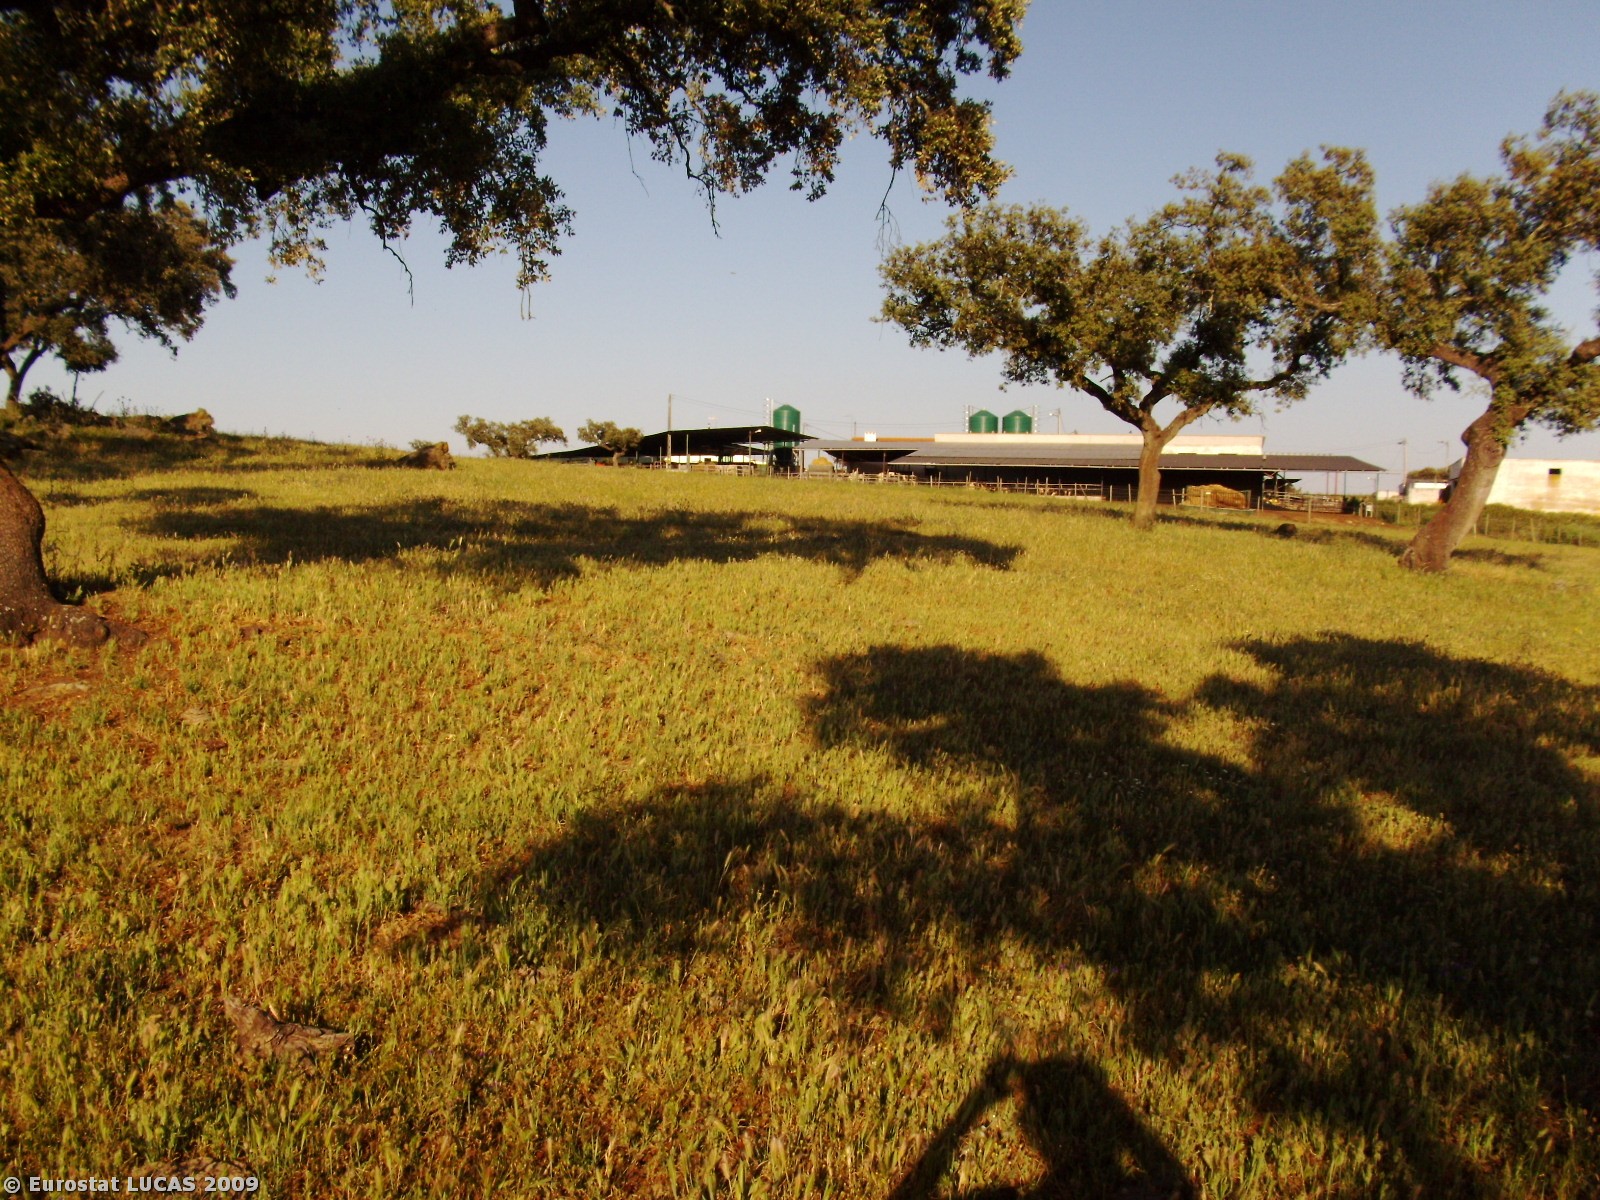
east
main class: Woodland
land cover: Broadleaved woodland
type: broadleaved evergreen forest
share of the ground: 10 - 25 %
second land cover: Spontaneously vegetated surfaces
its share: 25 - 50 %
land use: Agriculture (excluding fallow land and kitchen gardens)
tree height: > 5 m
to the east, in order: Broadleaved woodland; Spontaneously vegetated surfaces; Fences; Tracks; Artificial constructions in urban areas; Electric lines; Tracks
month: May
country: PT
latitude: 38.7933
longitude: -7.2875
